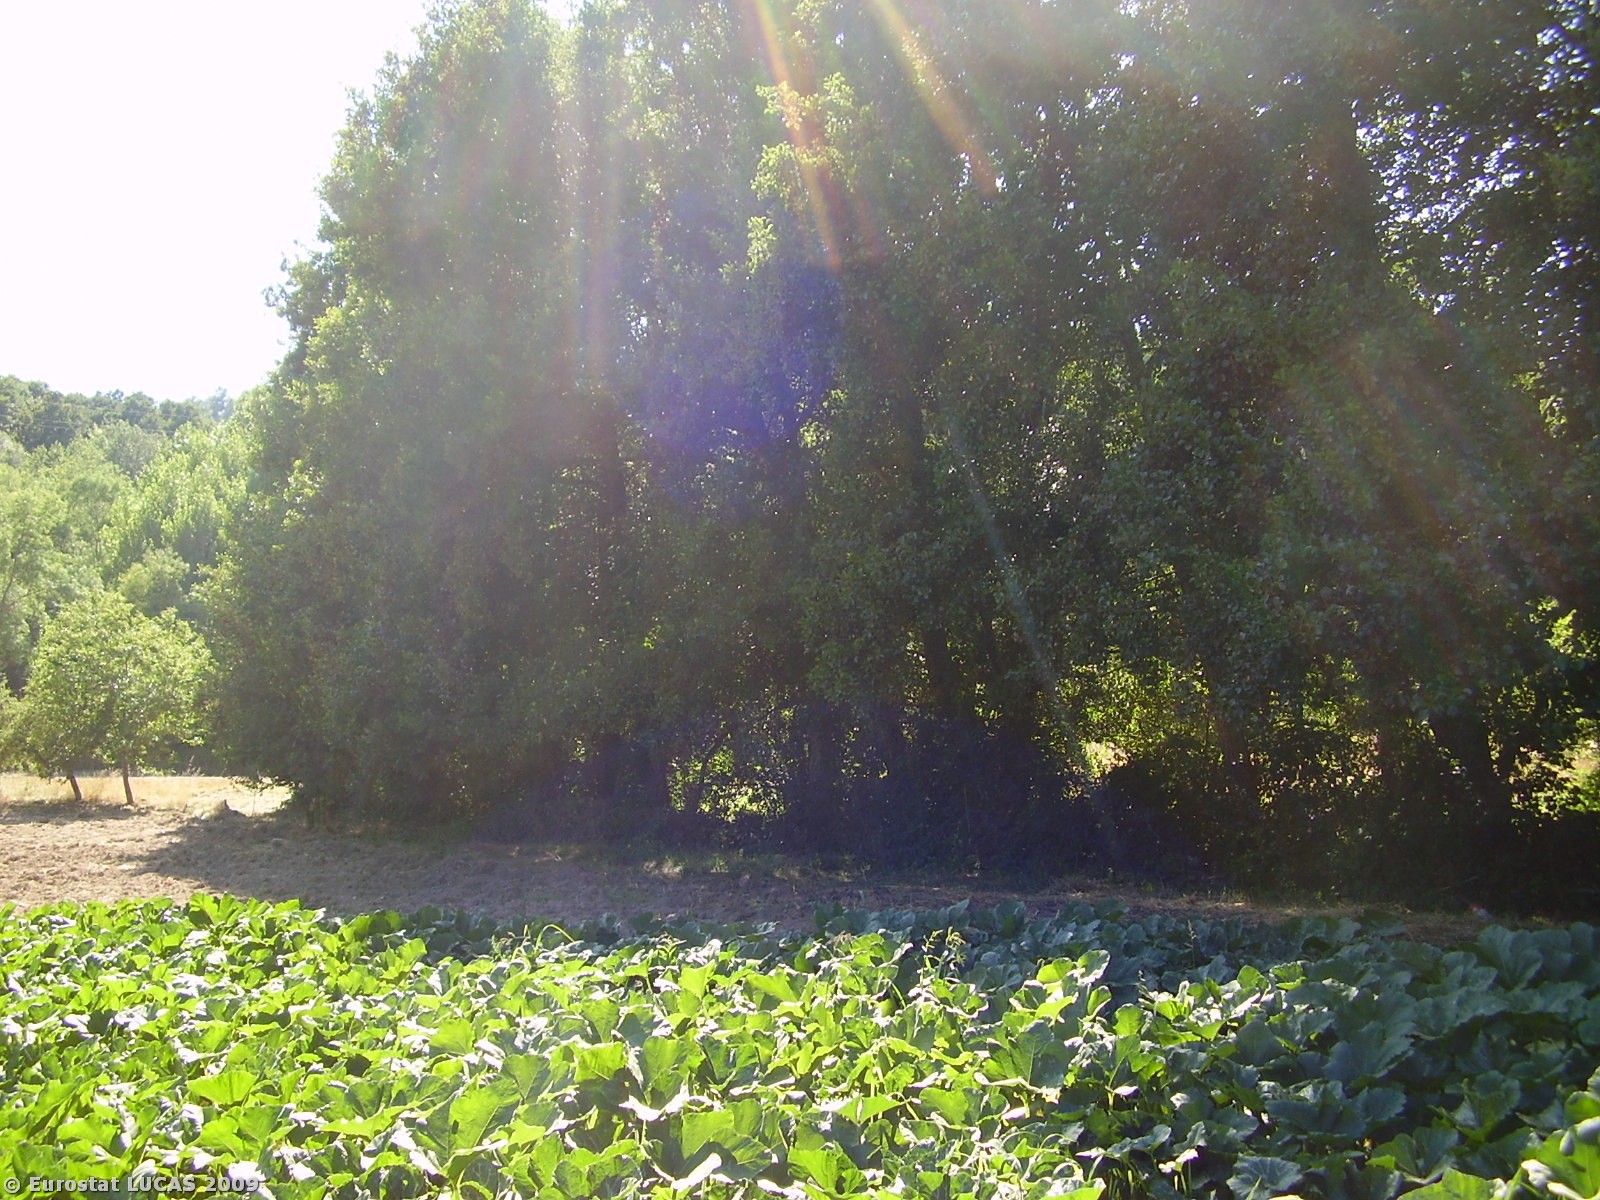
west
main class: Cropland
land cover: Mixed cereals for fodder
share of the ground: > 75 %
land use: Agriculture (excluding fallow land and kitchen gardens)
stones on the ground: < 10 %
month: July
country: PT
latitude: 41.6361
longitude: -7.3768
